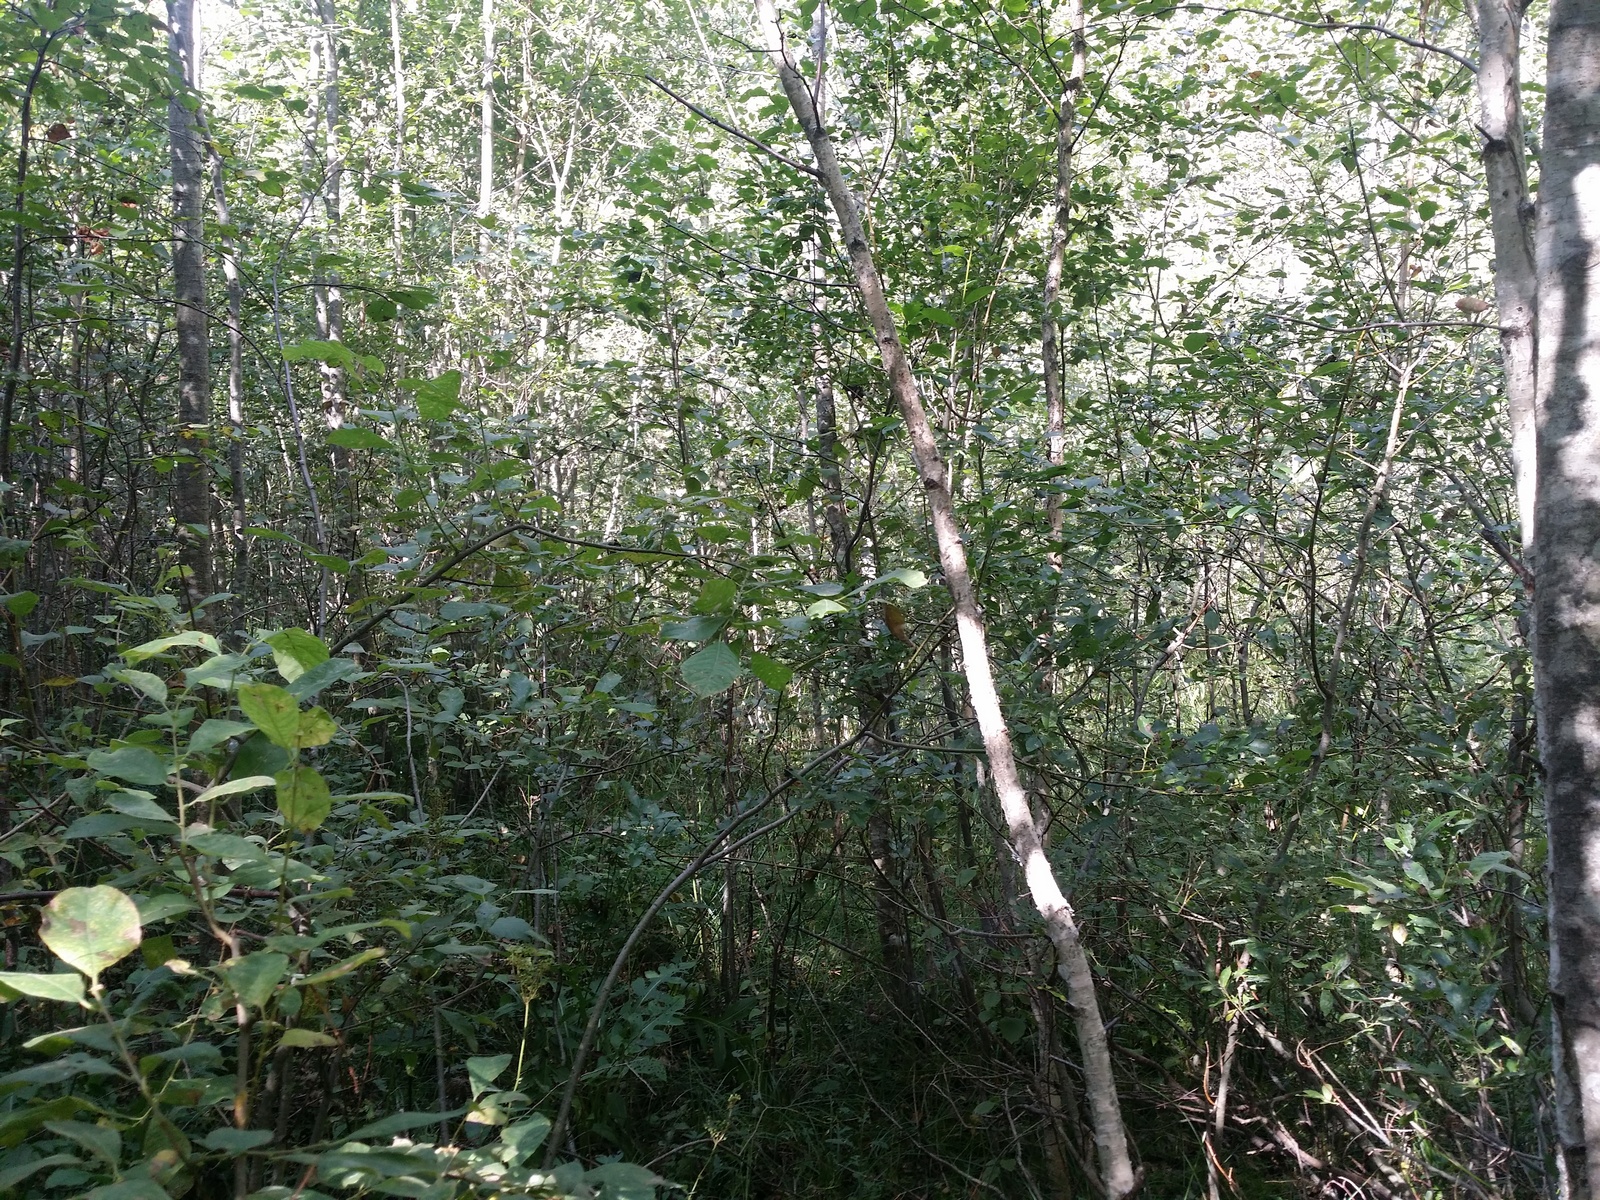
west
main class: Woodland
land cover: Broadleaved woodland
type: non-riverine alder, birch or aspen forest
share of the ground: > 75 %
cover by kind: broadleaved forest trees 85 %, herbaceous plants 15 %
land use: Semi-natural and natural areas not in use
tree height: < 5 m
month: August
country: LV
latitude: 57.5065
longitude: 26.8947
